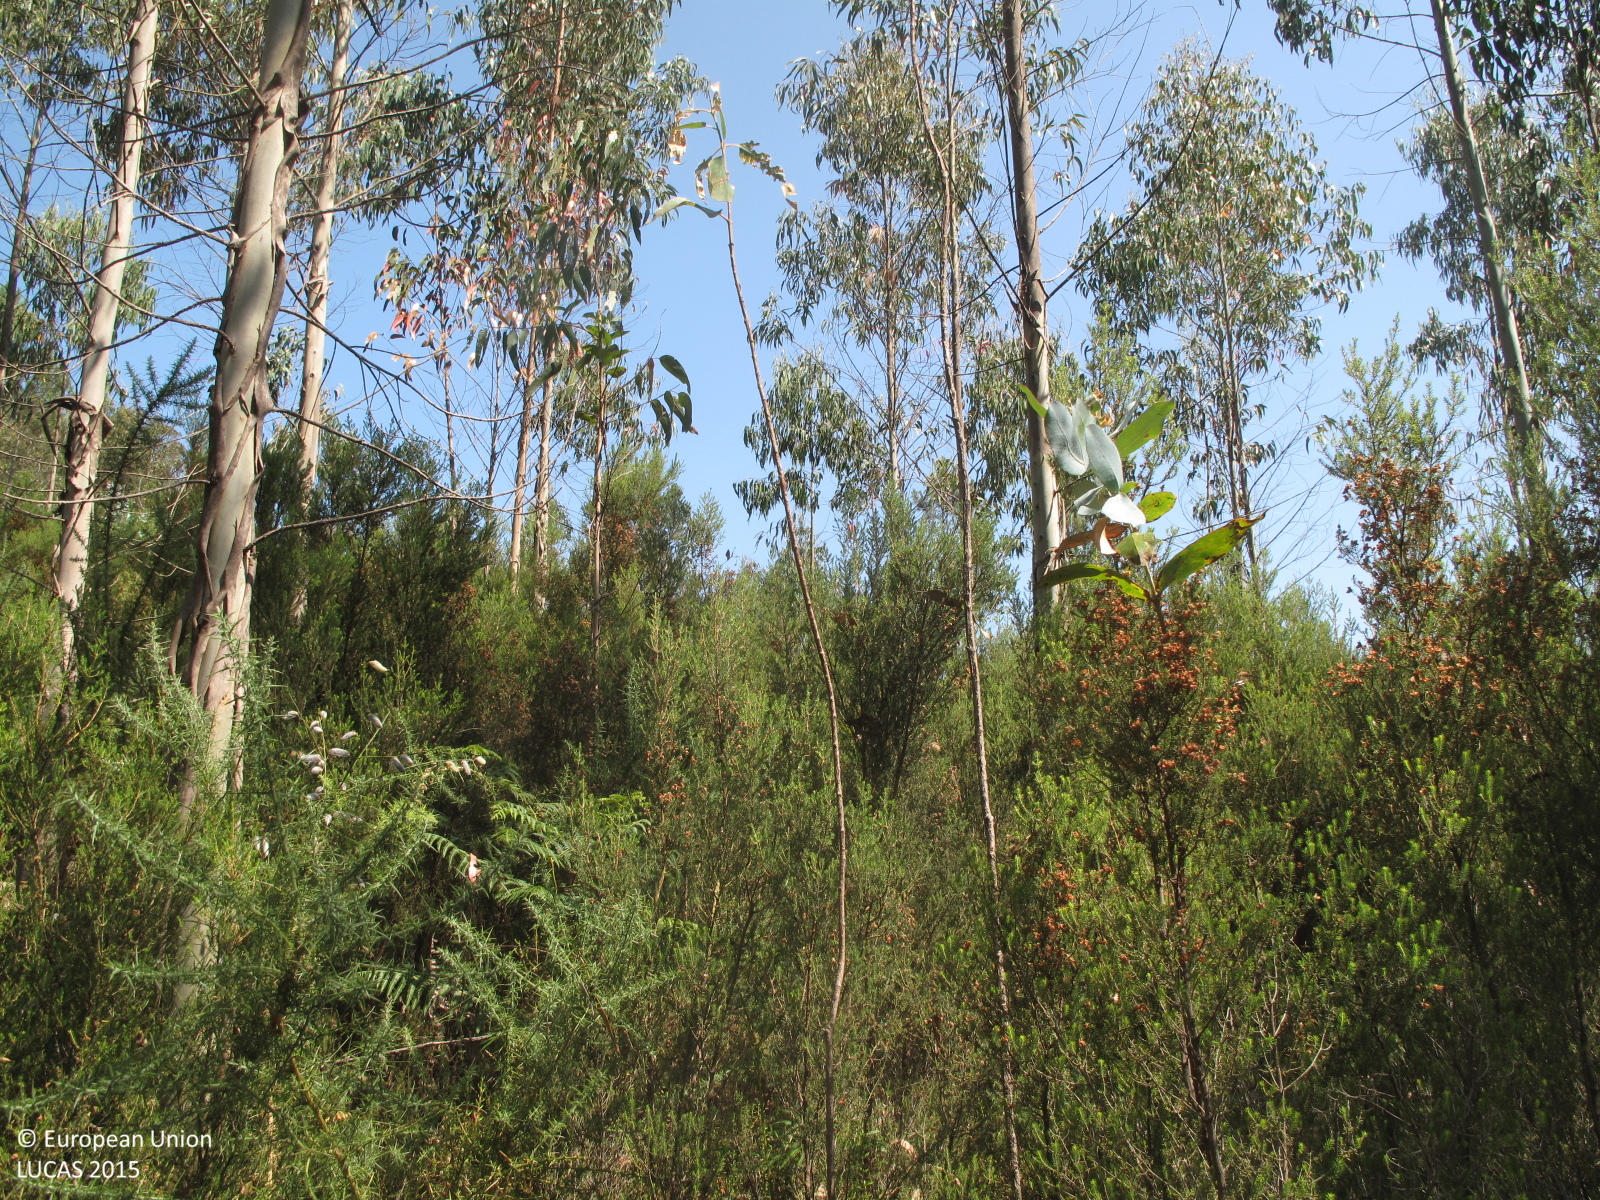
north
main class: Woodland
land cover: Broadleaved woodland
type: exotic forest
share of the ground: > 75 %
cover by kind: broadleaved forest trees 45 %, shrubs 30 %, herbaceous plants 20 %, coniferous forest trees 5 %
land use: Forestry
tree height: > 5 m
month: July
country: ES
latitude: 43.3953
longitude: -8.0603
